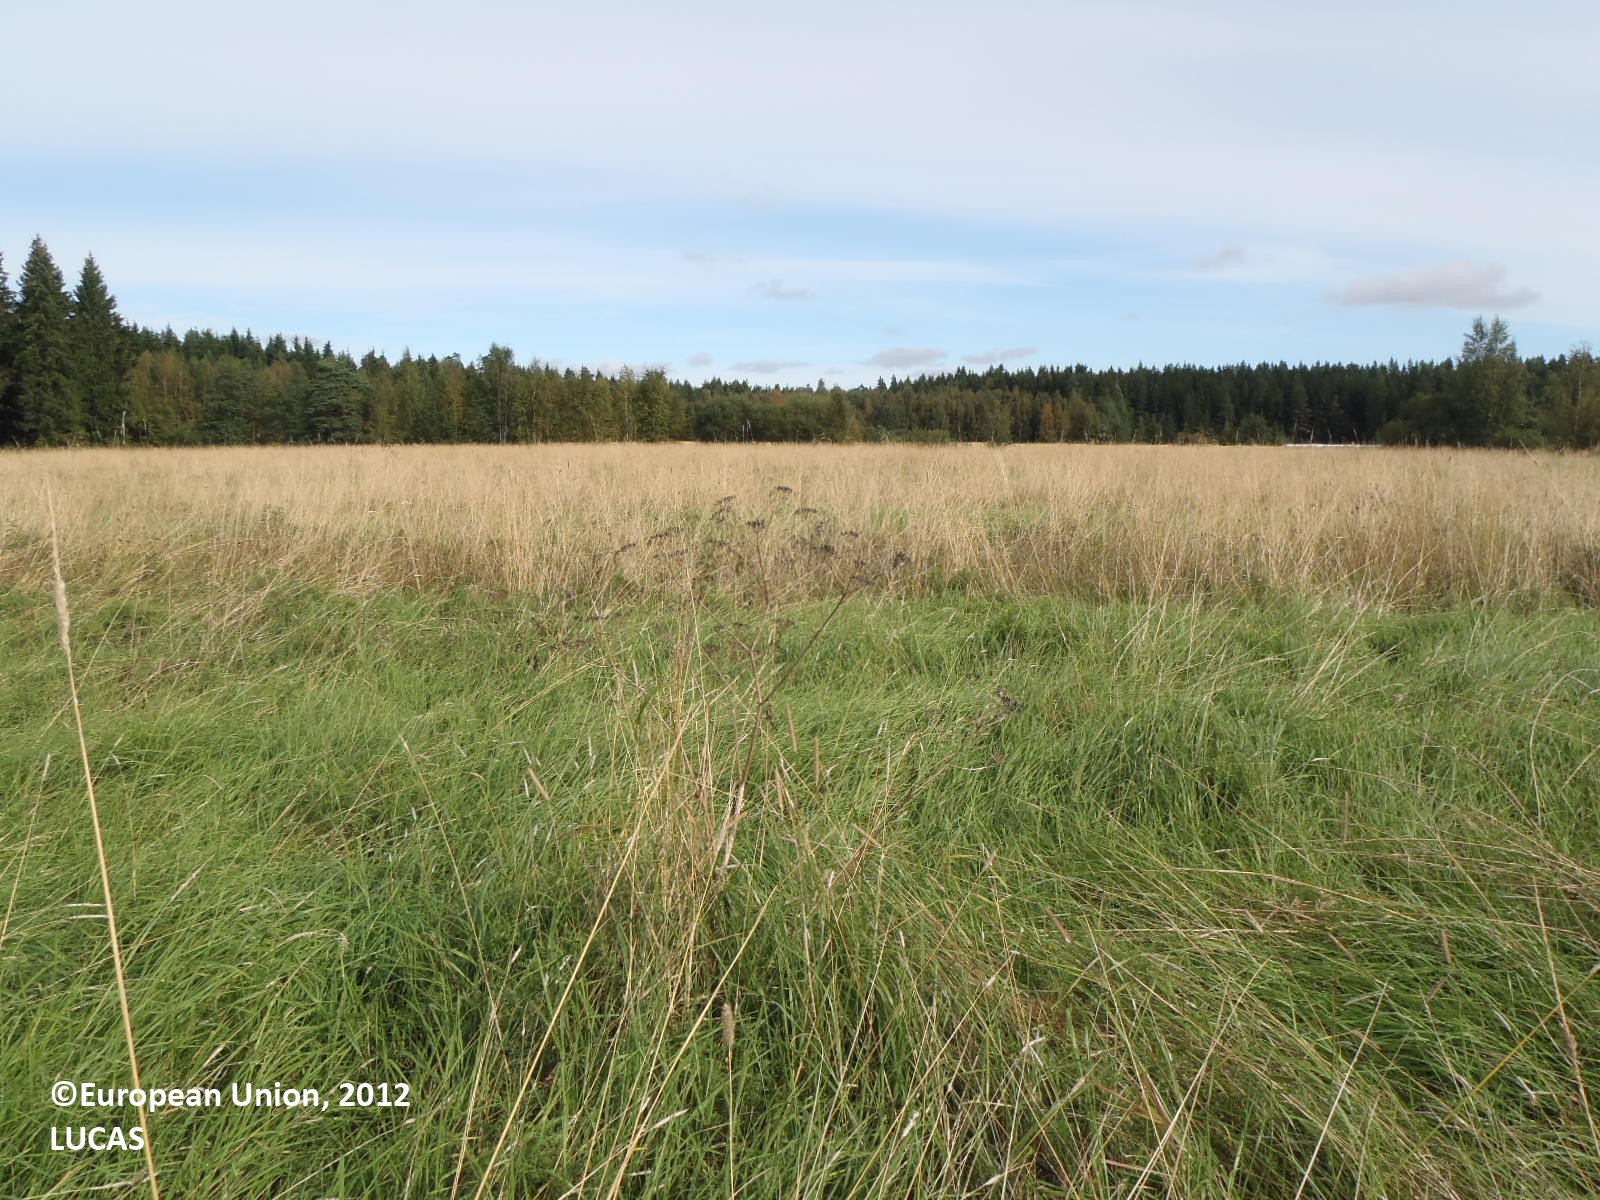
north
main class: Cropland
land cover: Temporary grasslands
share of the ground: > 75 %
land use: Agriculture (excluding fallow land and kitchen gardens)
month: August
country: FI
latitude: 60.7134
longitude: 22.5496
